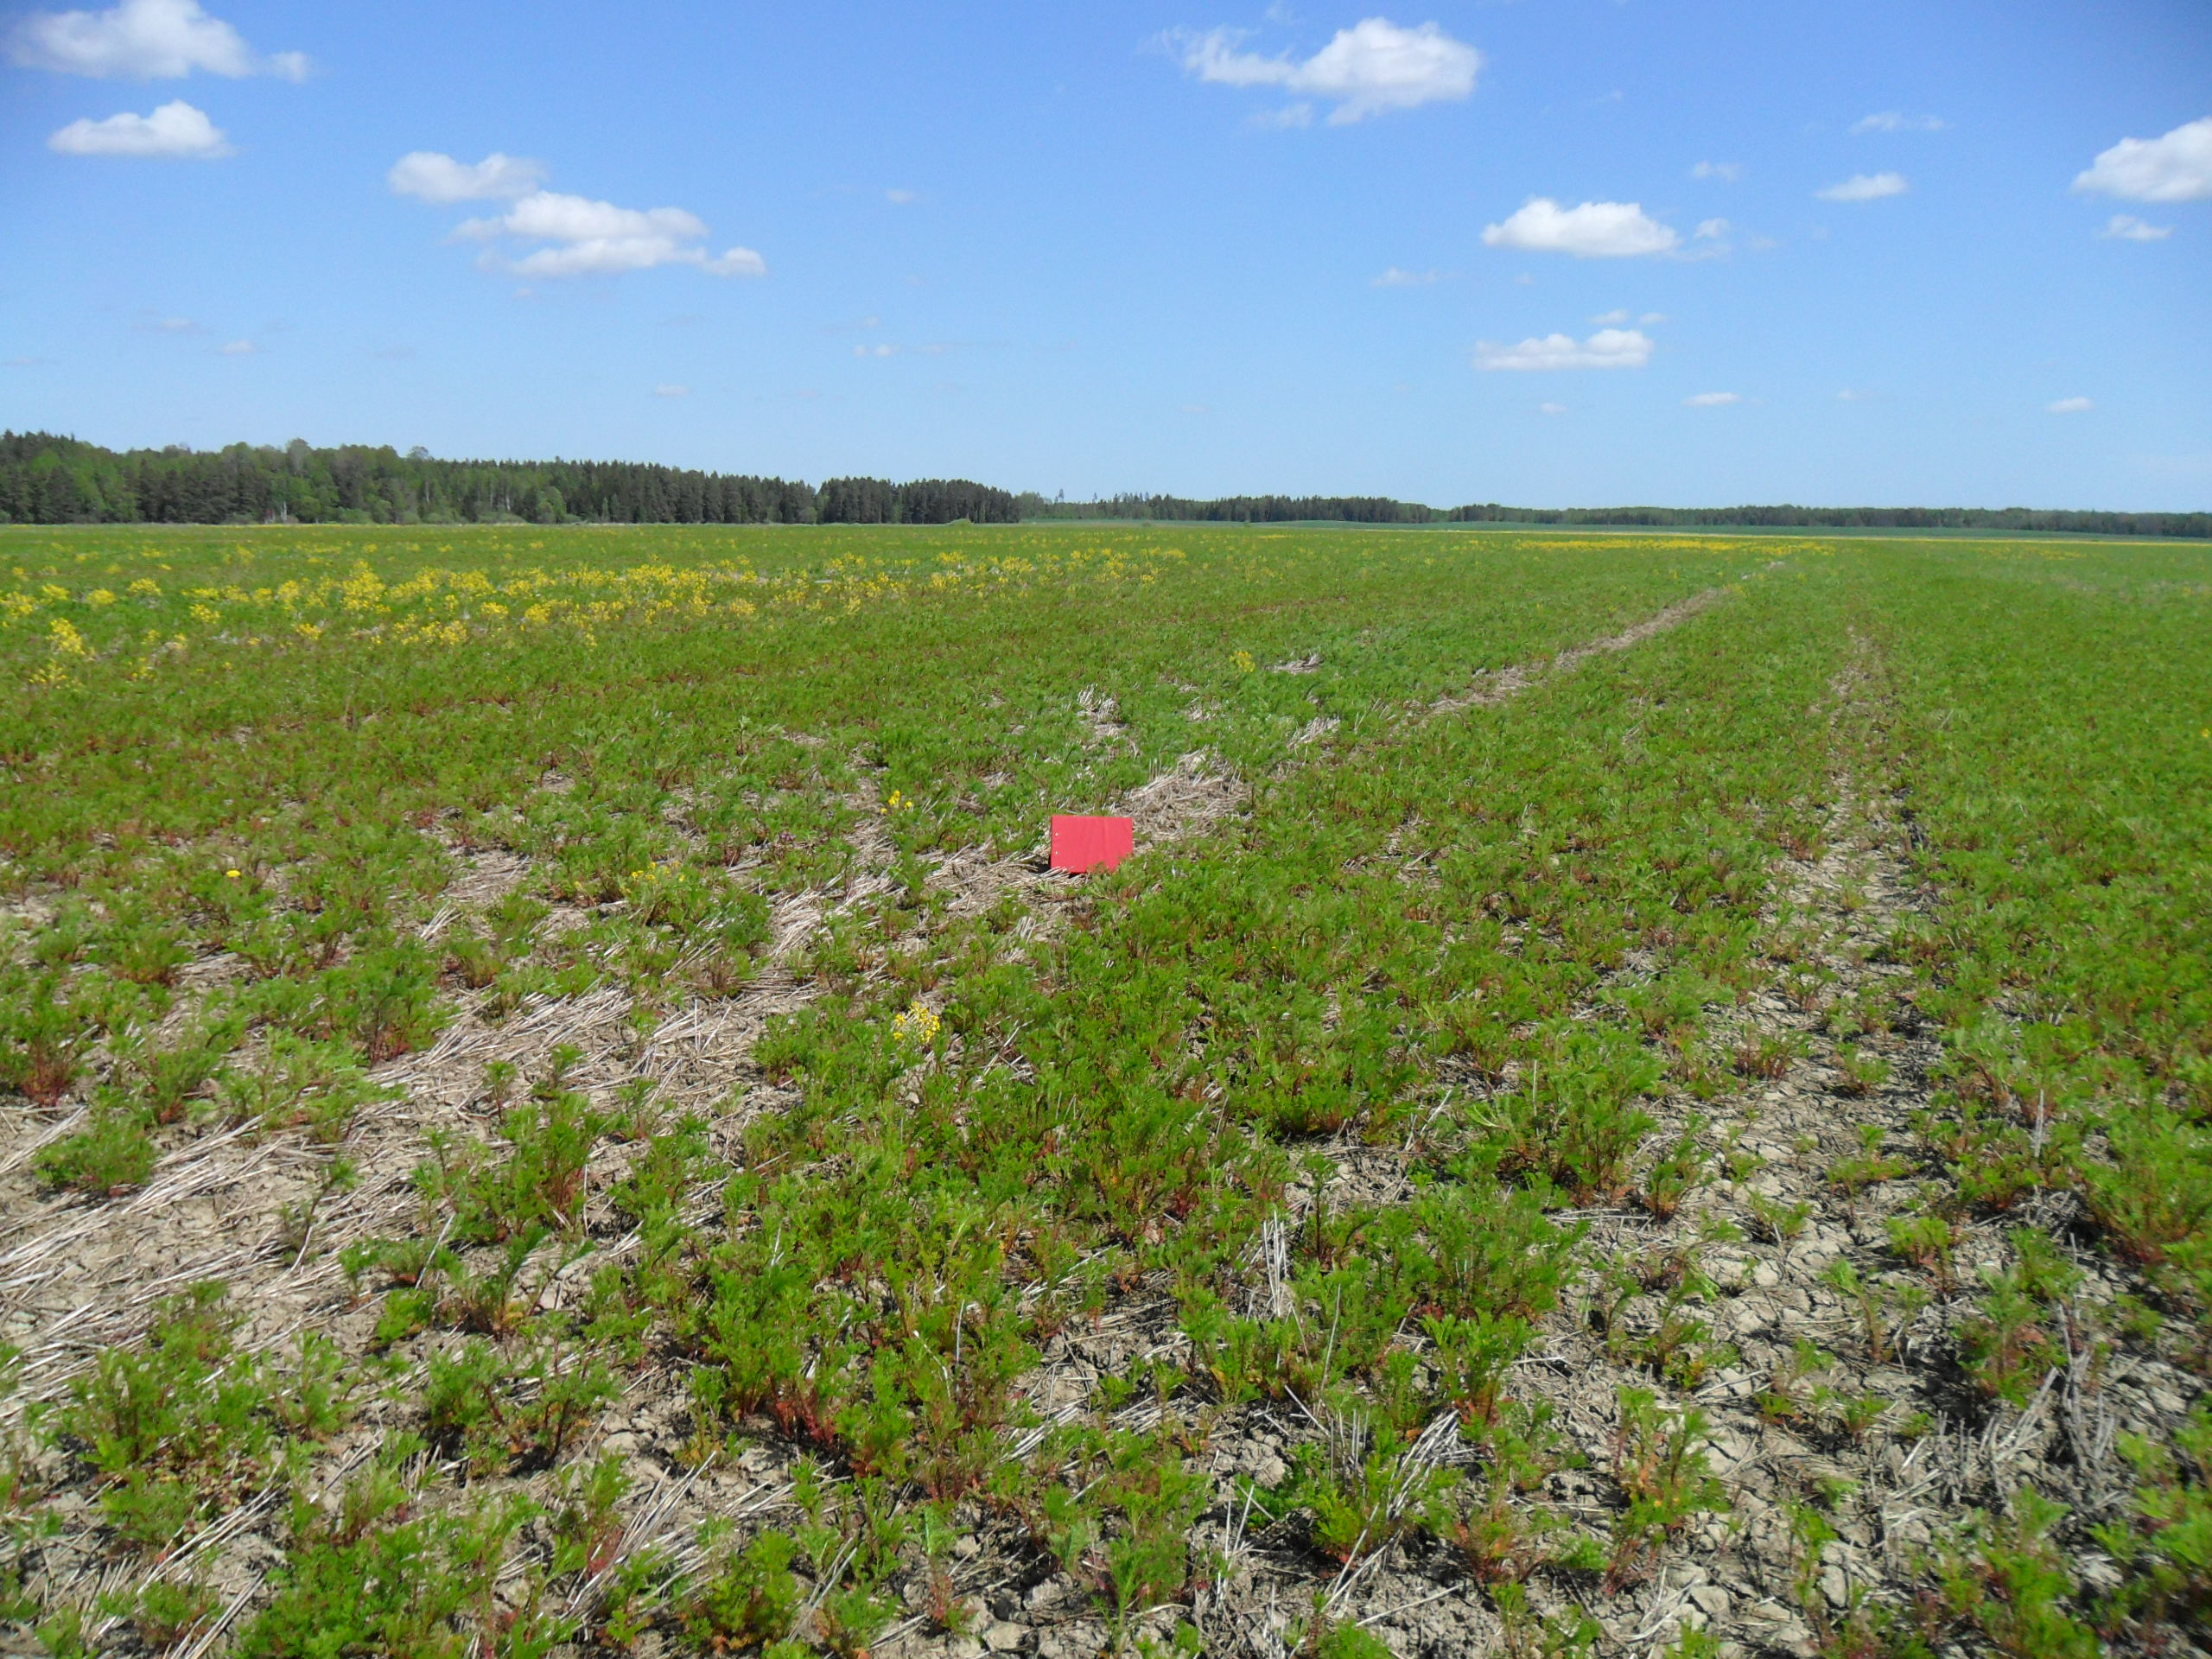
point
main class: Grassland
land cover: Spontaneously vegetated surfaces
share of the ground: 25 - 50 %
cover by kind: unconsolidated bare surface 55 %, herbaceous plants 45 %
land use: Fallow land
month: May
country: LV
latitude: 57.2801
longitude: 22.3764
